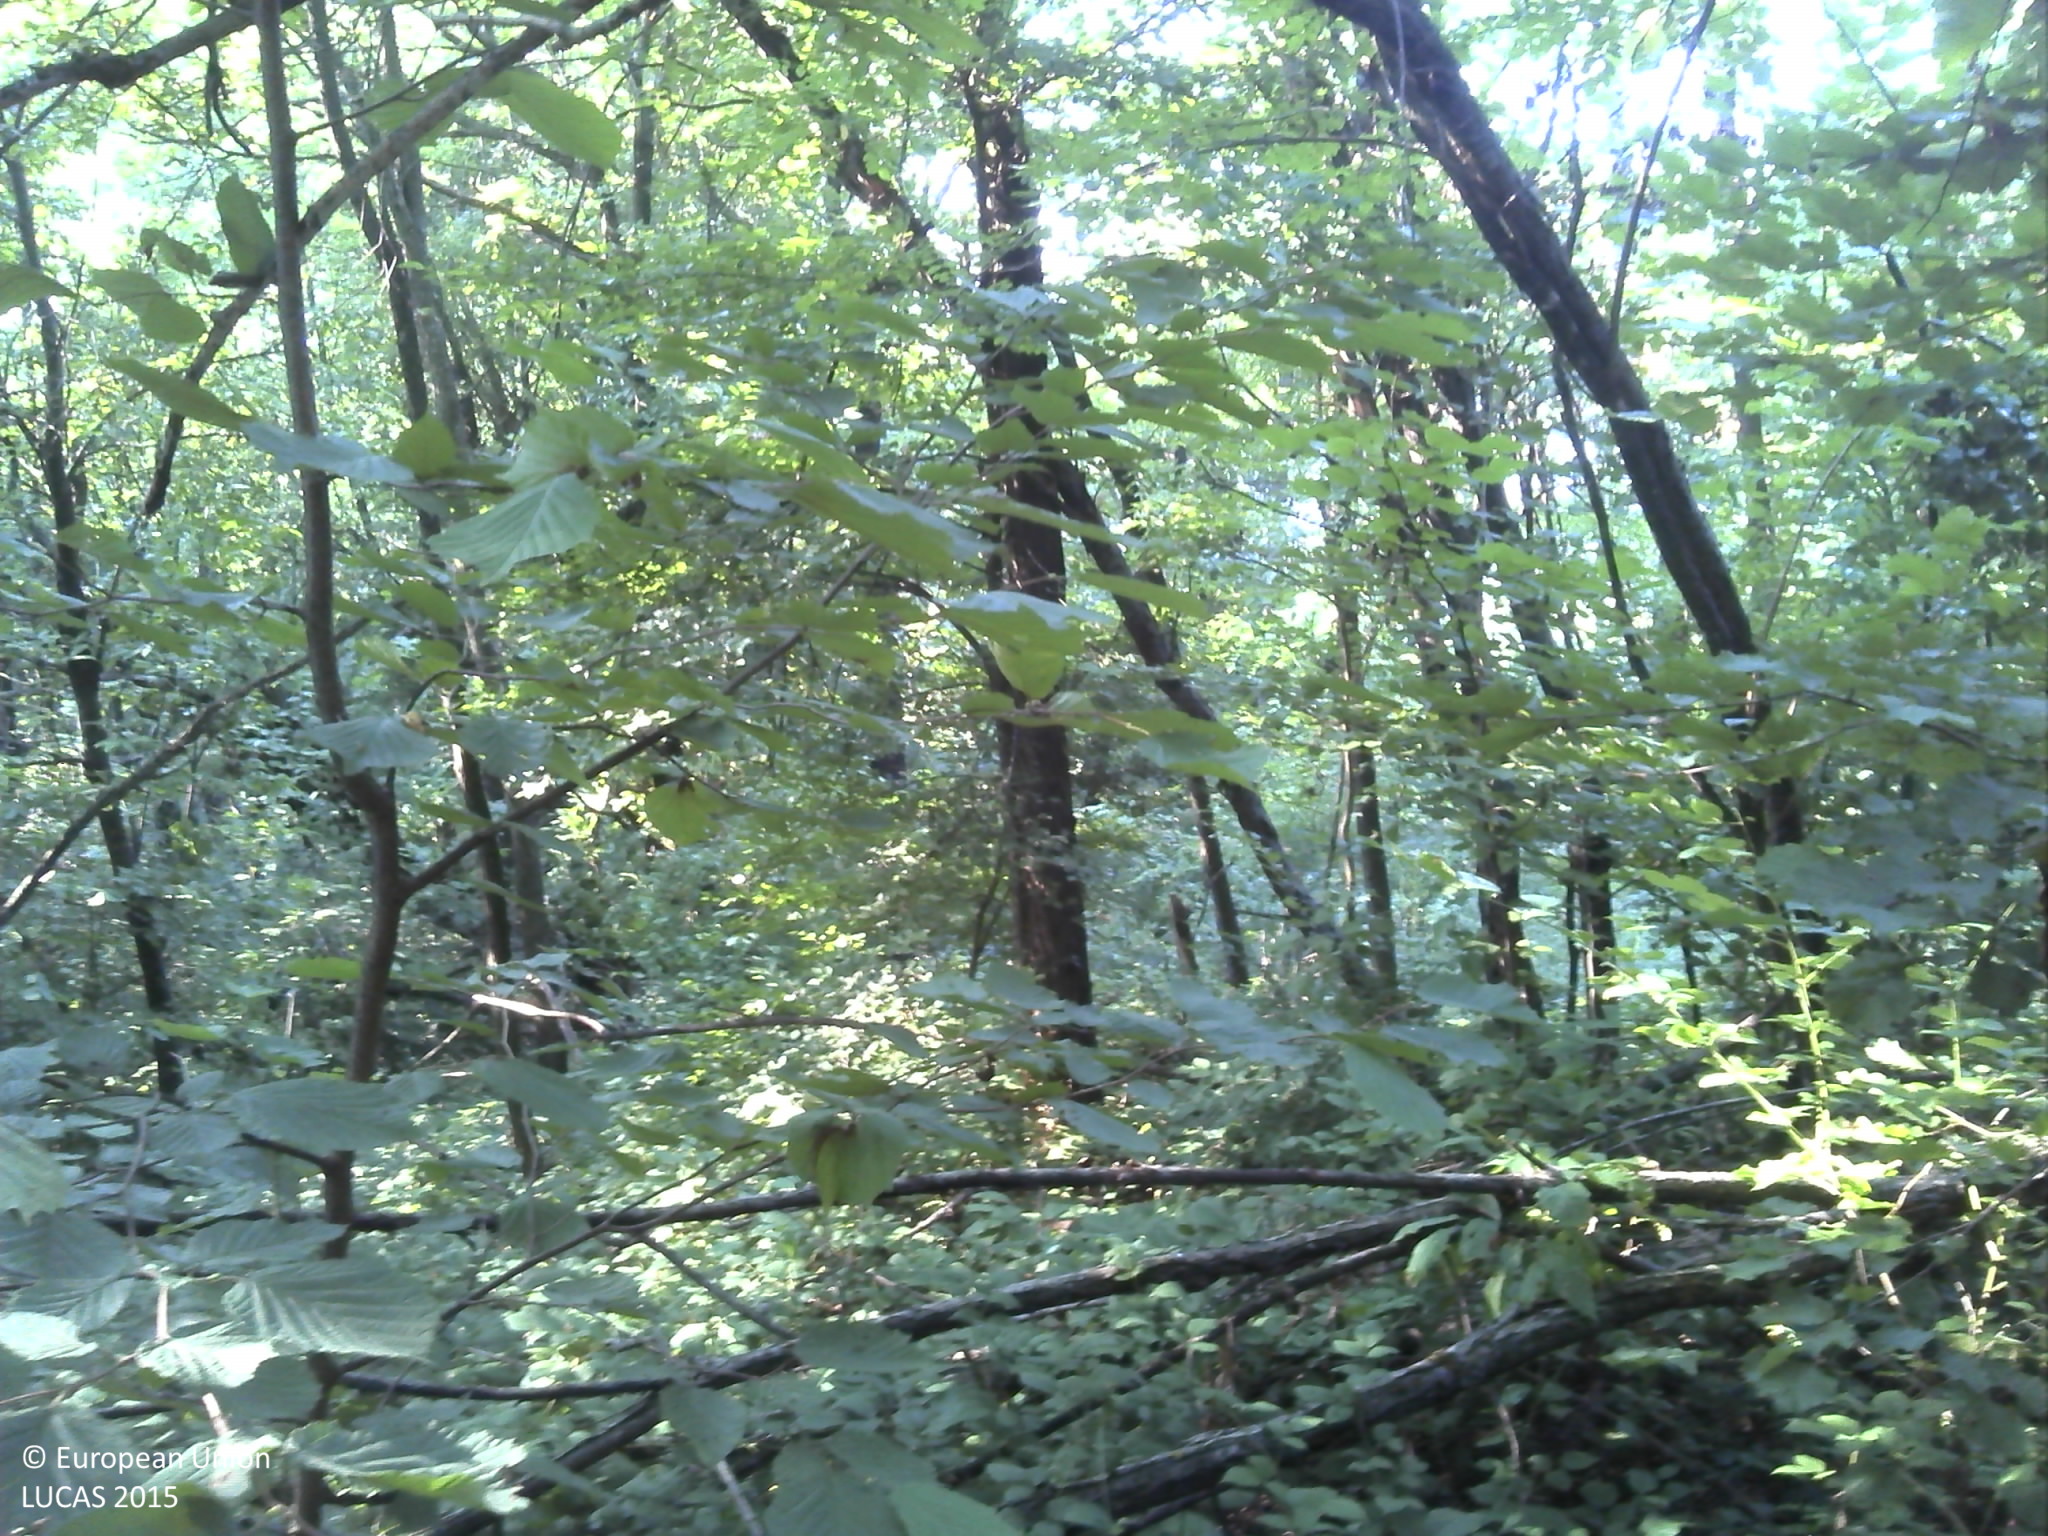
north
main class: Woodland
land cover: Broadleaved woodland
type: acidophilous oak and oak-birch forest
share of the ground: > 75 %
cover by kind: broadleaved forest trees 100 %
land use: Forestry
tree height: > 5 m
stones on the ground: < 10 %
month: August
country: HR
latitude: 45.3709
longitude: 16.2921
